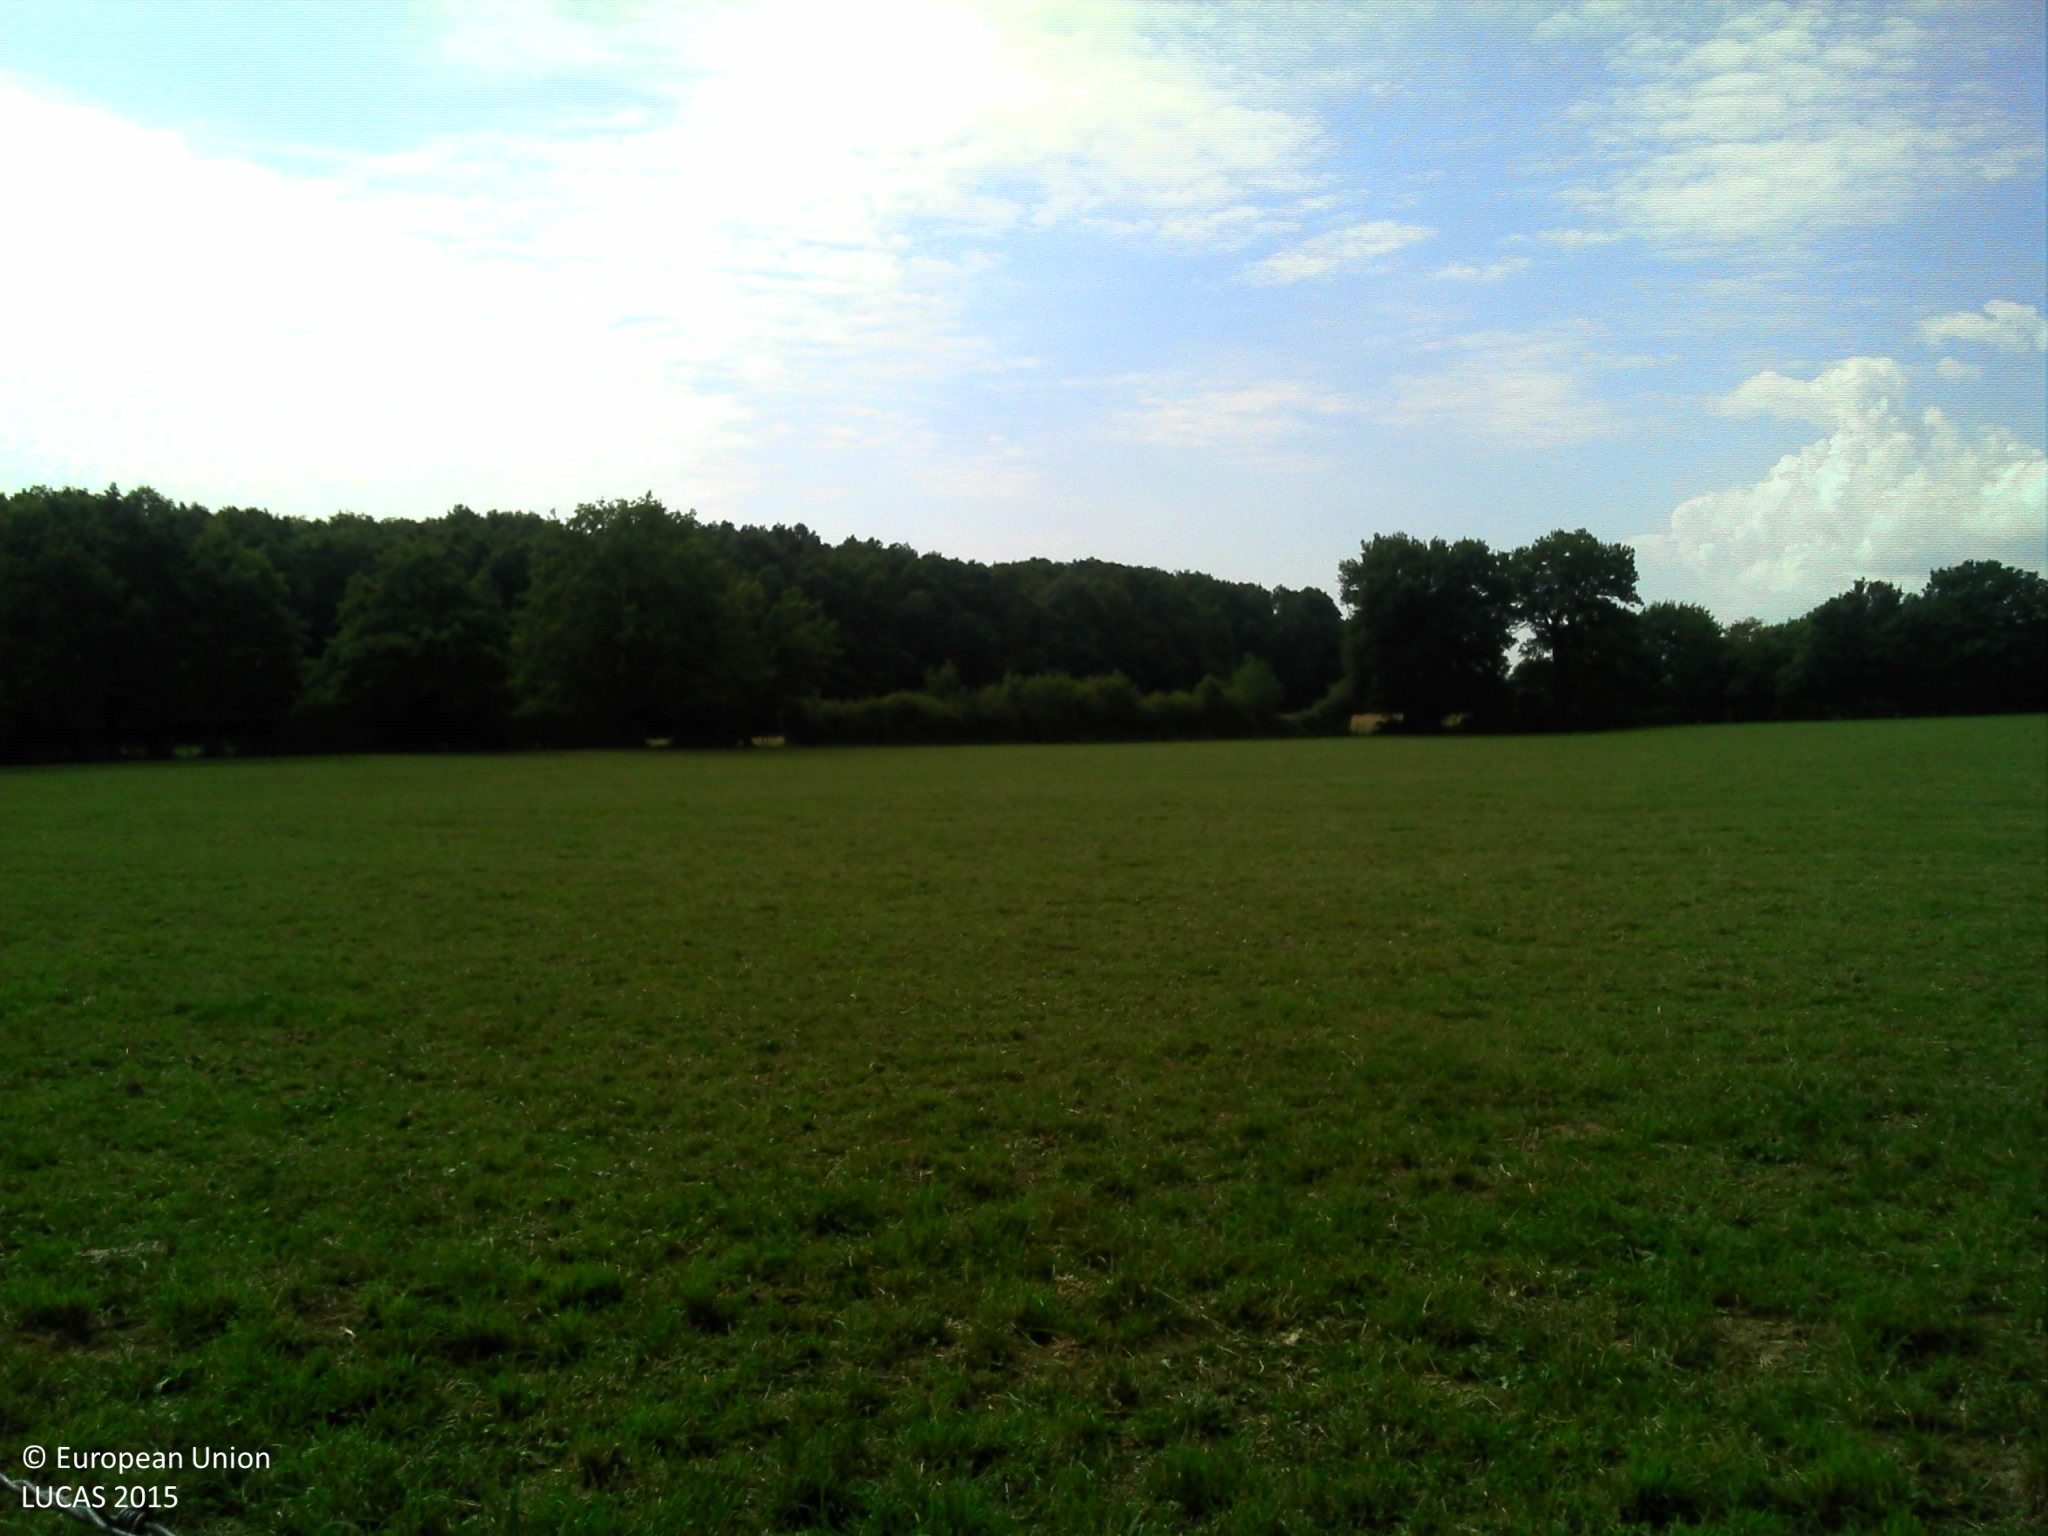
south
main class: Grassland
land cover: Grassland without tree/shrub cover
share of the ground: > 75 %
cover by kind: herbaceous plants 100 %
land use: Agriculture (excluding fallow land and kitchen gardens)
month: August
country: FR
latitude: 46.5163
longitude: 3.2332
